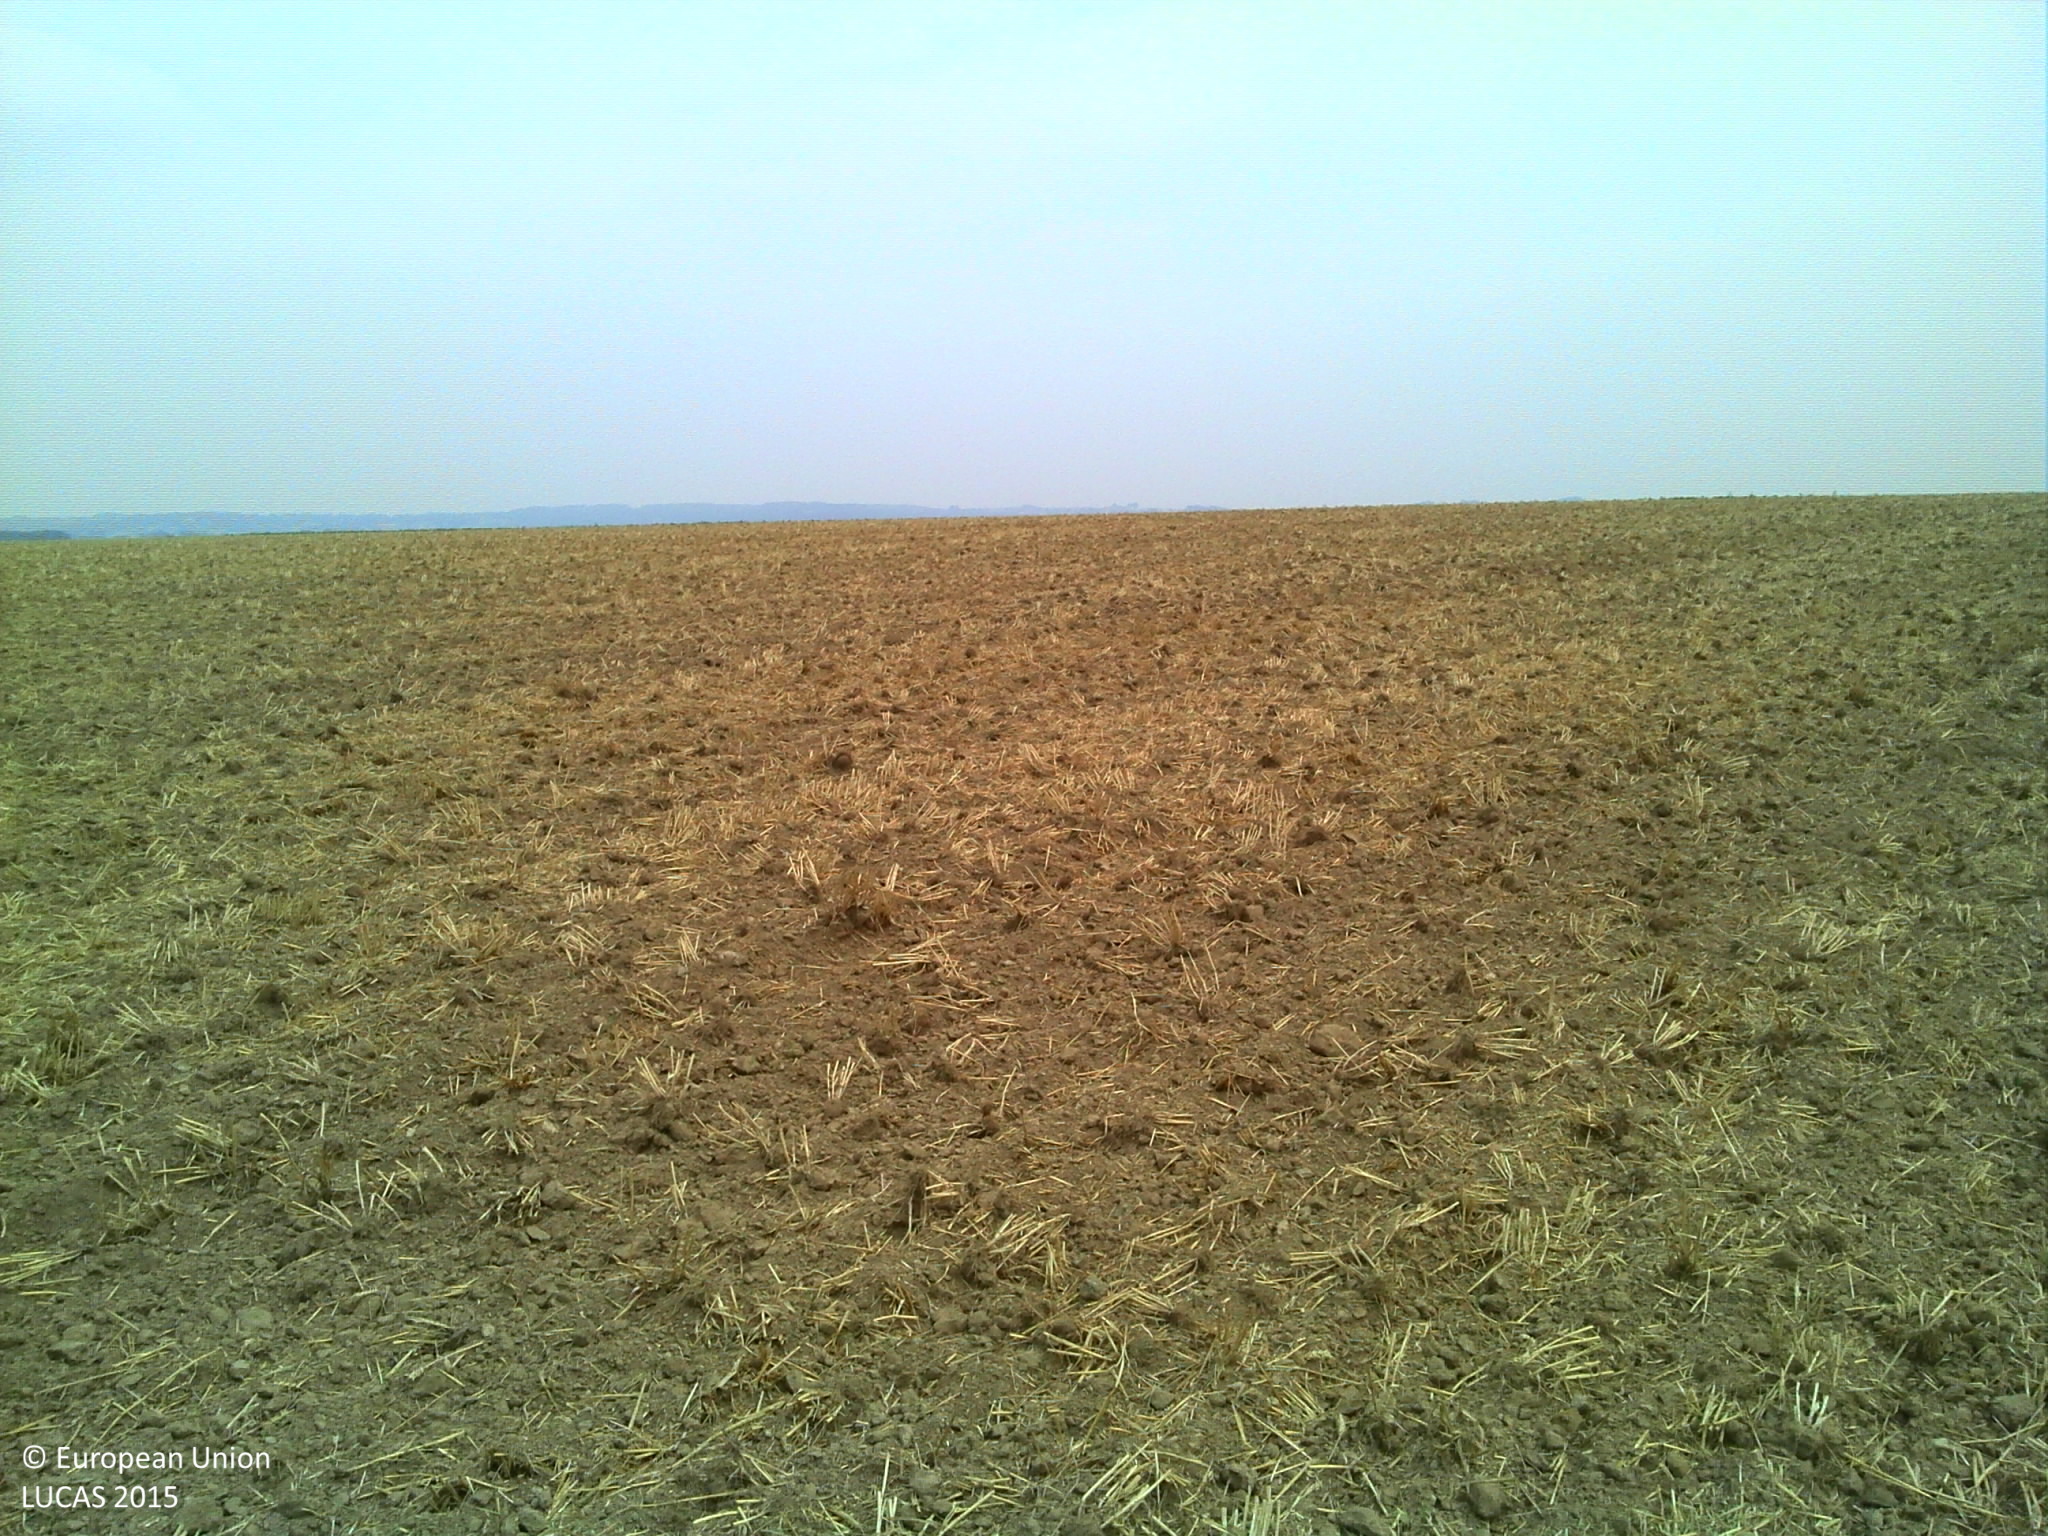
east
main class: Cropland
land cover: Common wheat
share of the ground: > 75 %
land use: Agriculture (excluding fallow land and kitchen gardens)
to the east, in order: Common wheat; Potatoes
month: August
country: BE
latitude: 50.7214
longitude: 3.5190
